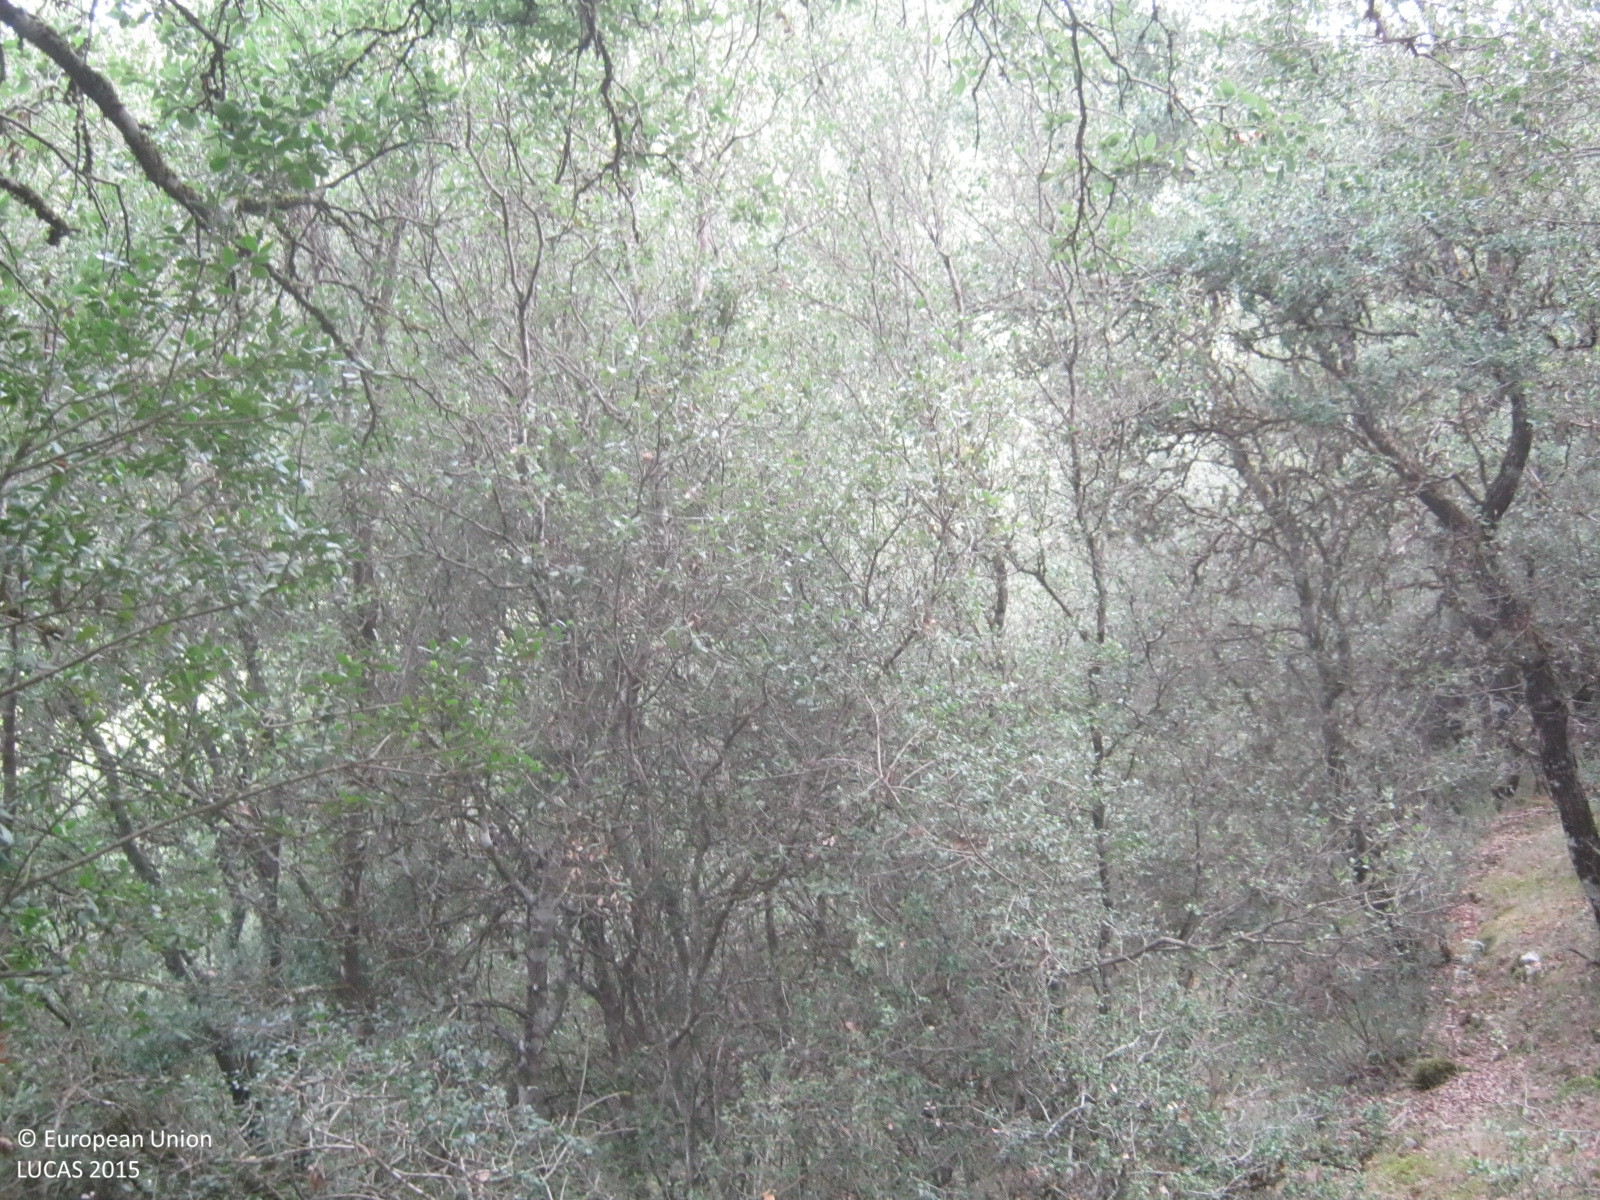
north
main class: Woodland
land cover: Broadleaved woodland
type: broadleaved evergreen forest
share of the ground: 50 - 75 %
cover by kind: broadleaved forest trees 65 %, shrubs 20 %, herbaceous plants 10 %, unconsolidated bare surface 5 %
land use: Semi-natural and natural areas not in use
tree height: > 5 m
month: September
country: GR
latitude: 37.8012
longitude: 22.0593
